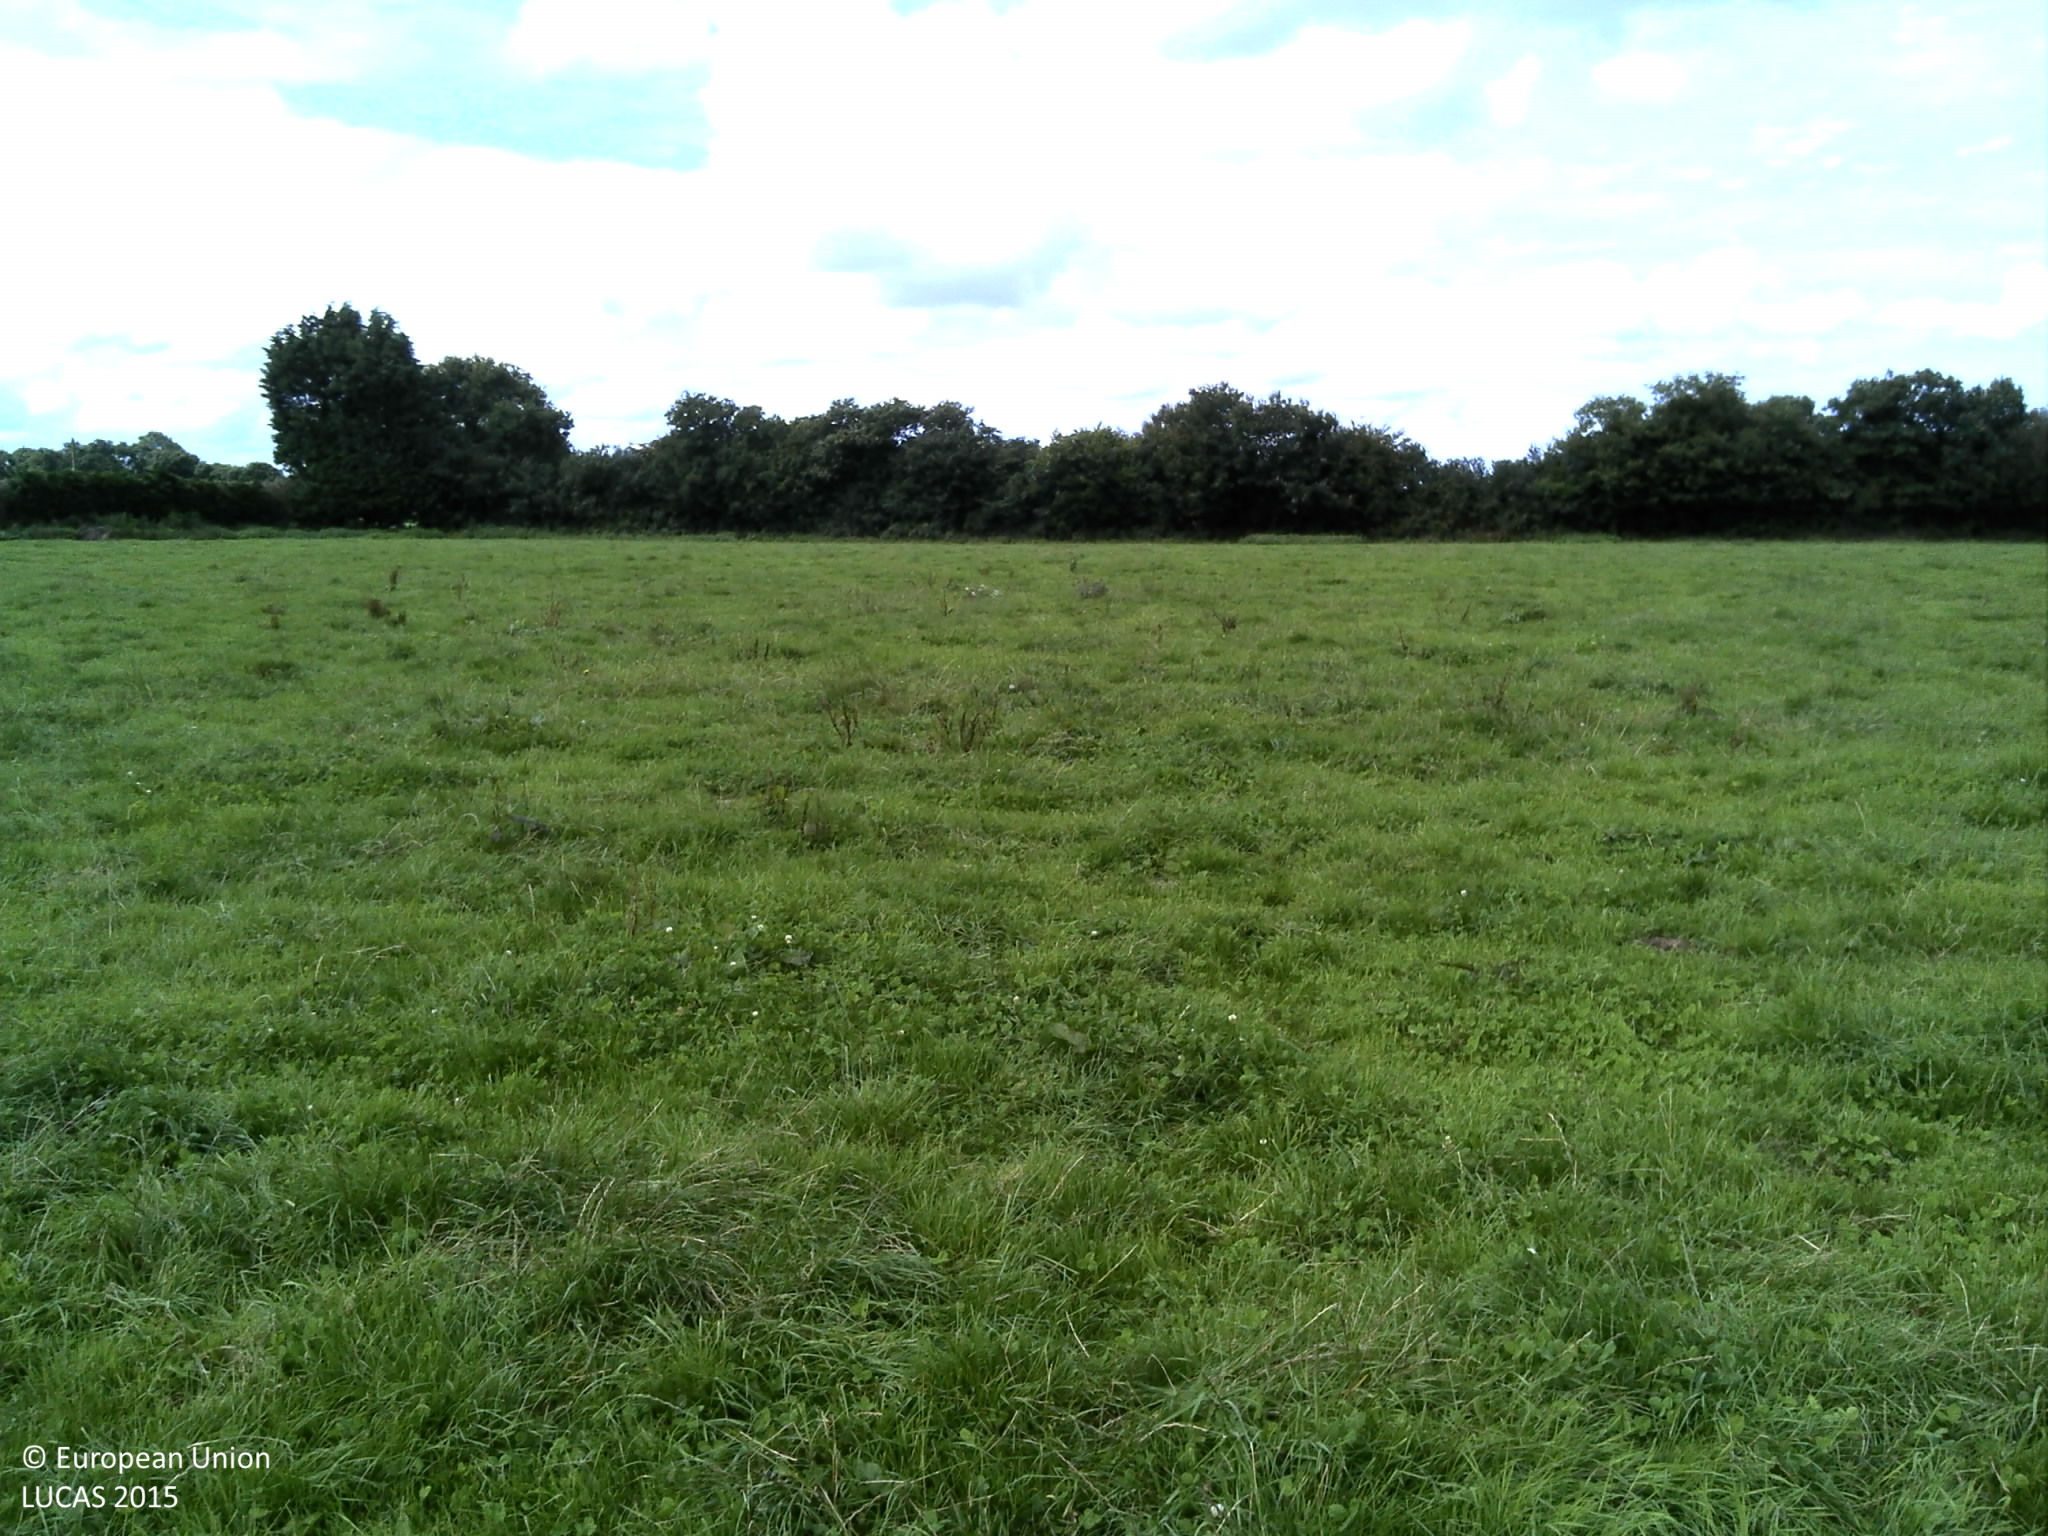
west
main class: Grassland
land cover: Grassland without tree/shrub cover
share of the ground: > 75 %
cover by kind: herbaceous plants 100 %
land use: Agriculture (excluding fallow land and kitchen gardens)
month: September
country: FR
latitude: 48.5205
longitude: -4.2145
